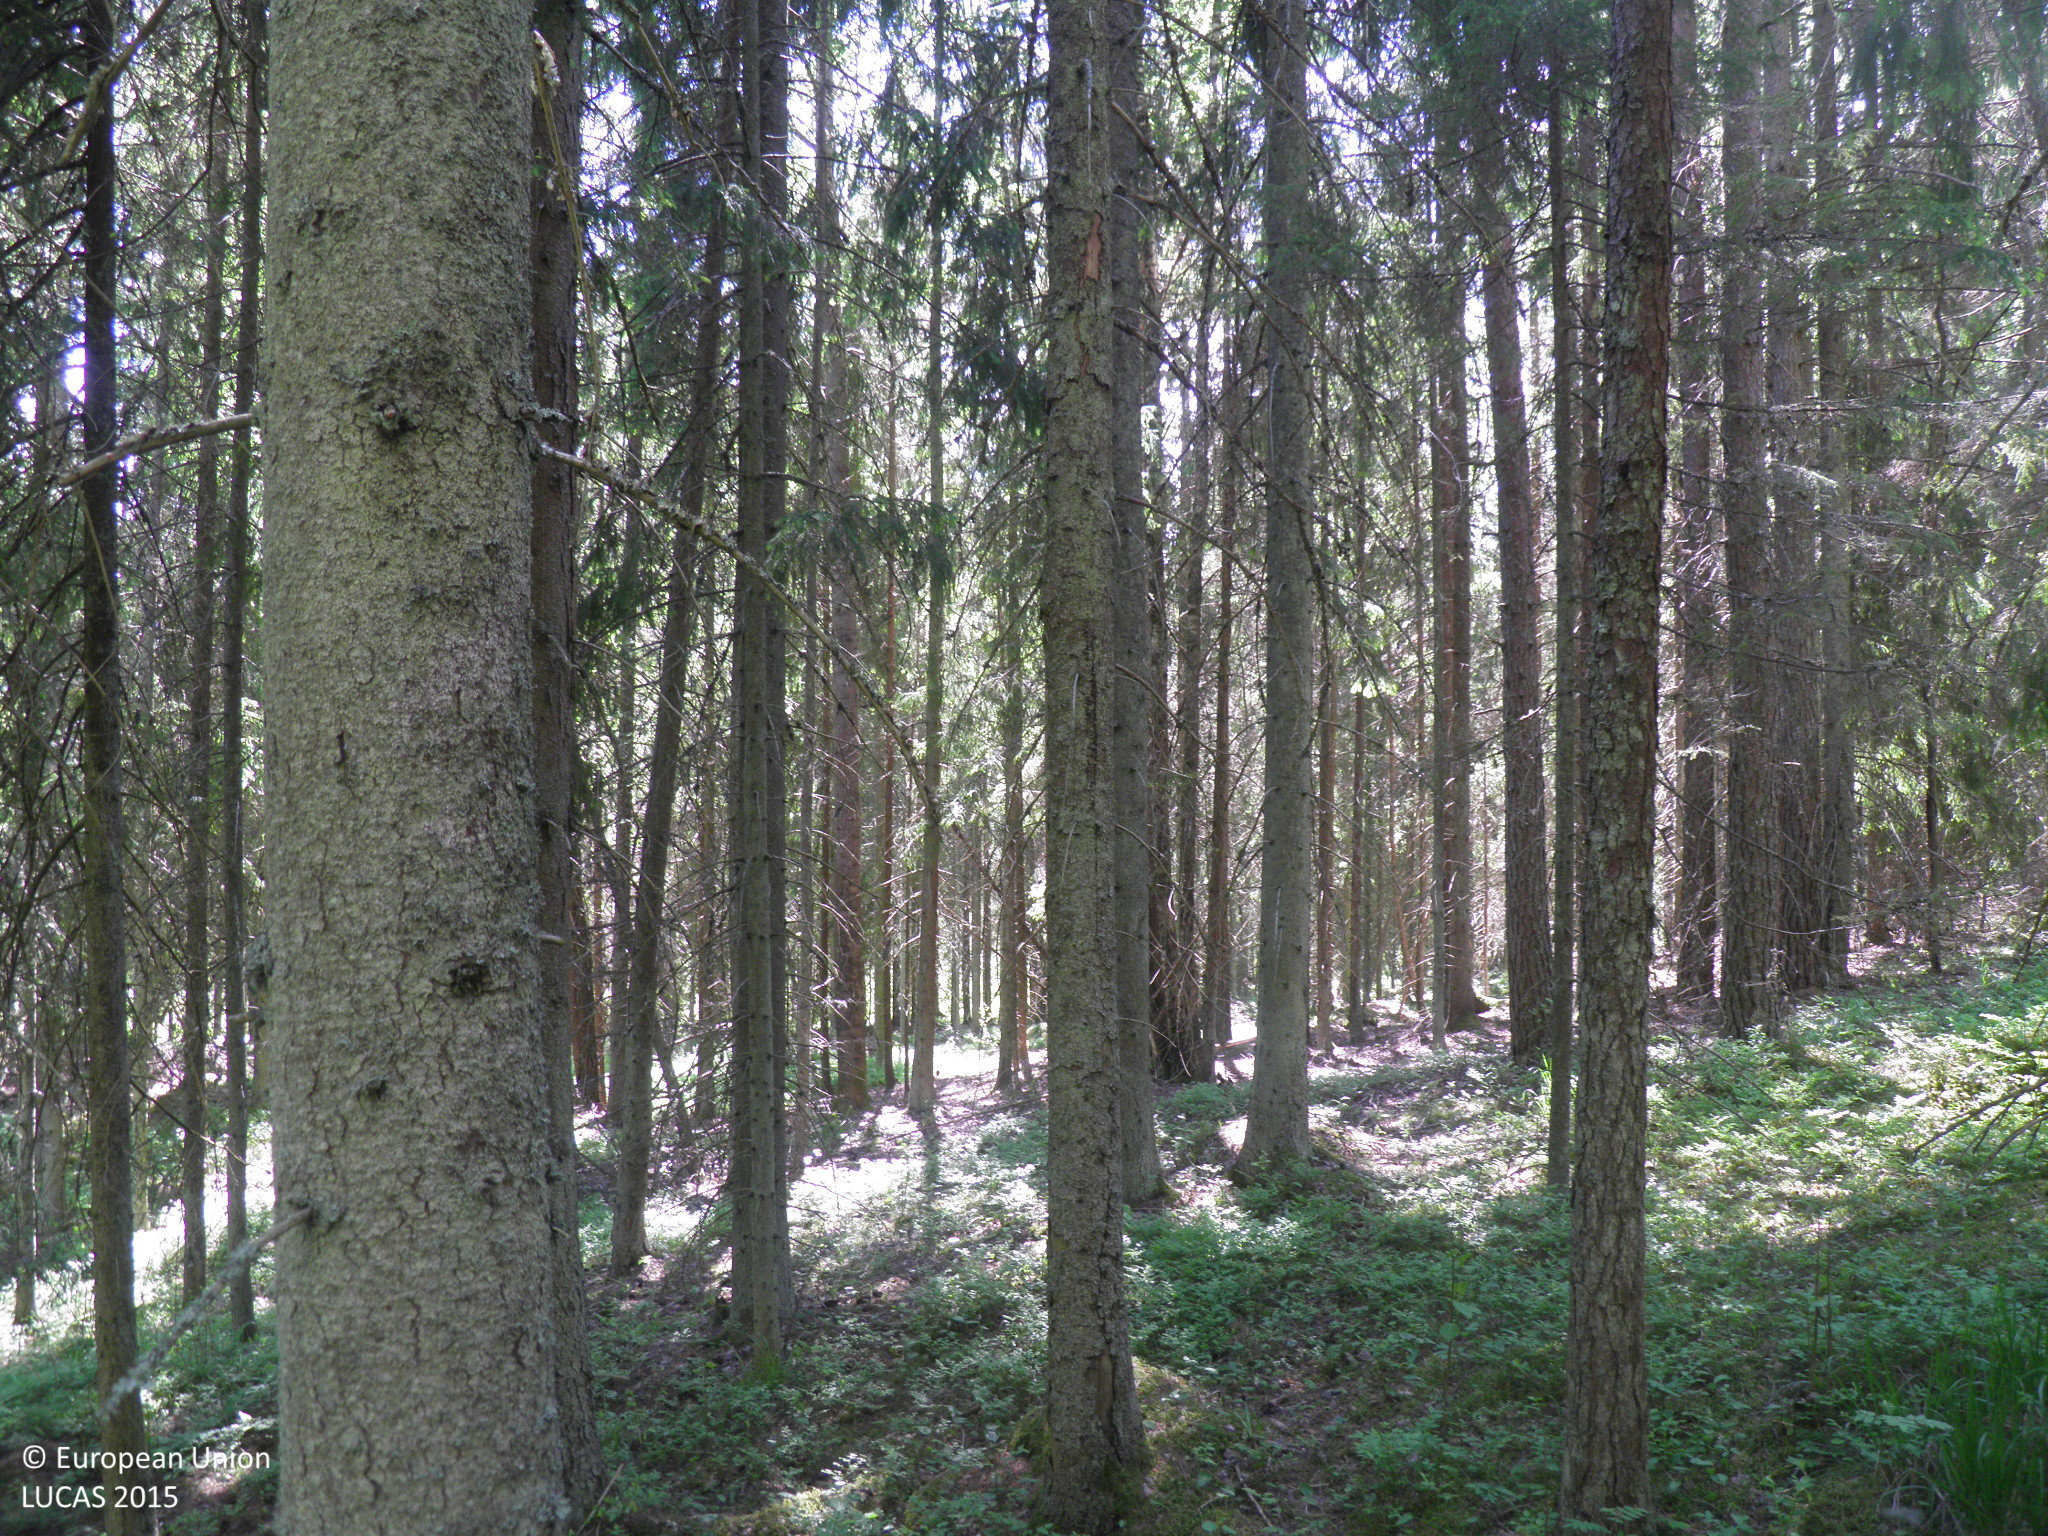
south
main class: Woodland
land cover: Spruce dominated coniferous woodland
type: hemiboreal forest and nemoral coniferous forest and mixed broadleaved-coniferous forest
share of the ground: > 75 %
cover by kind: coniferous forest trees 75 %, broadleaved forest trees 10 %, shrubs 5 %, herbaceous plants 5 %, lichens and mosses 5 %
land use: Semi-natural and natural areas not in use
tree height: > 5 m
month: June
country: FI
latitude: 60.4388
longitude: 22.5551
